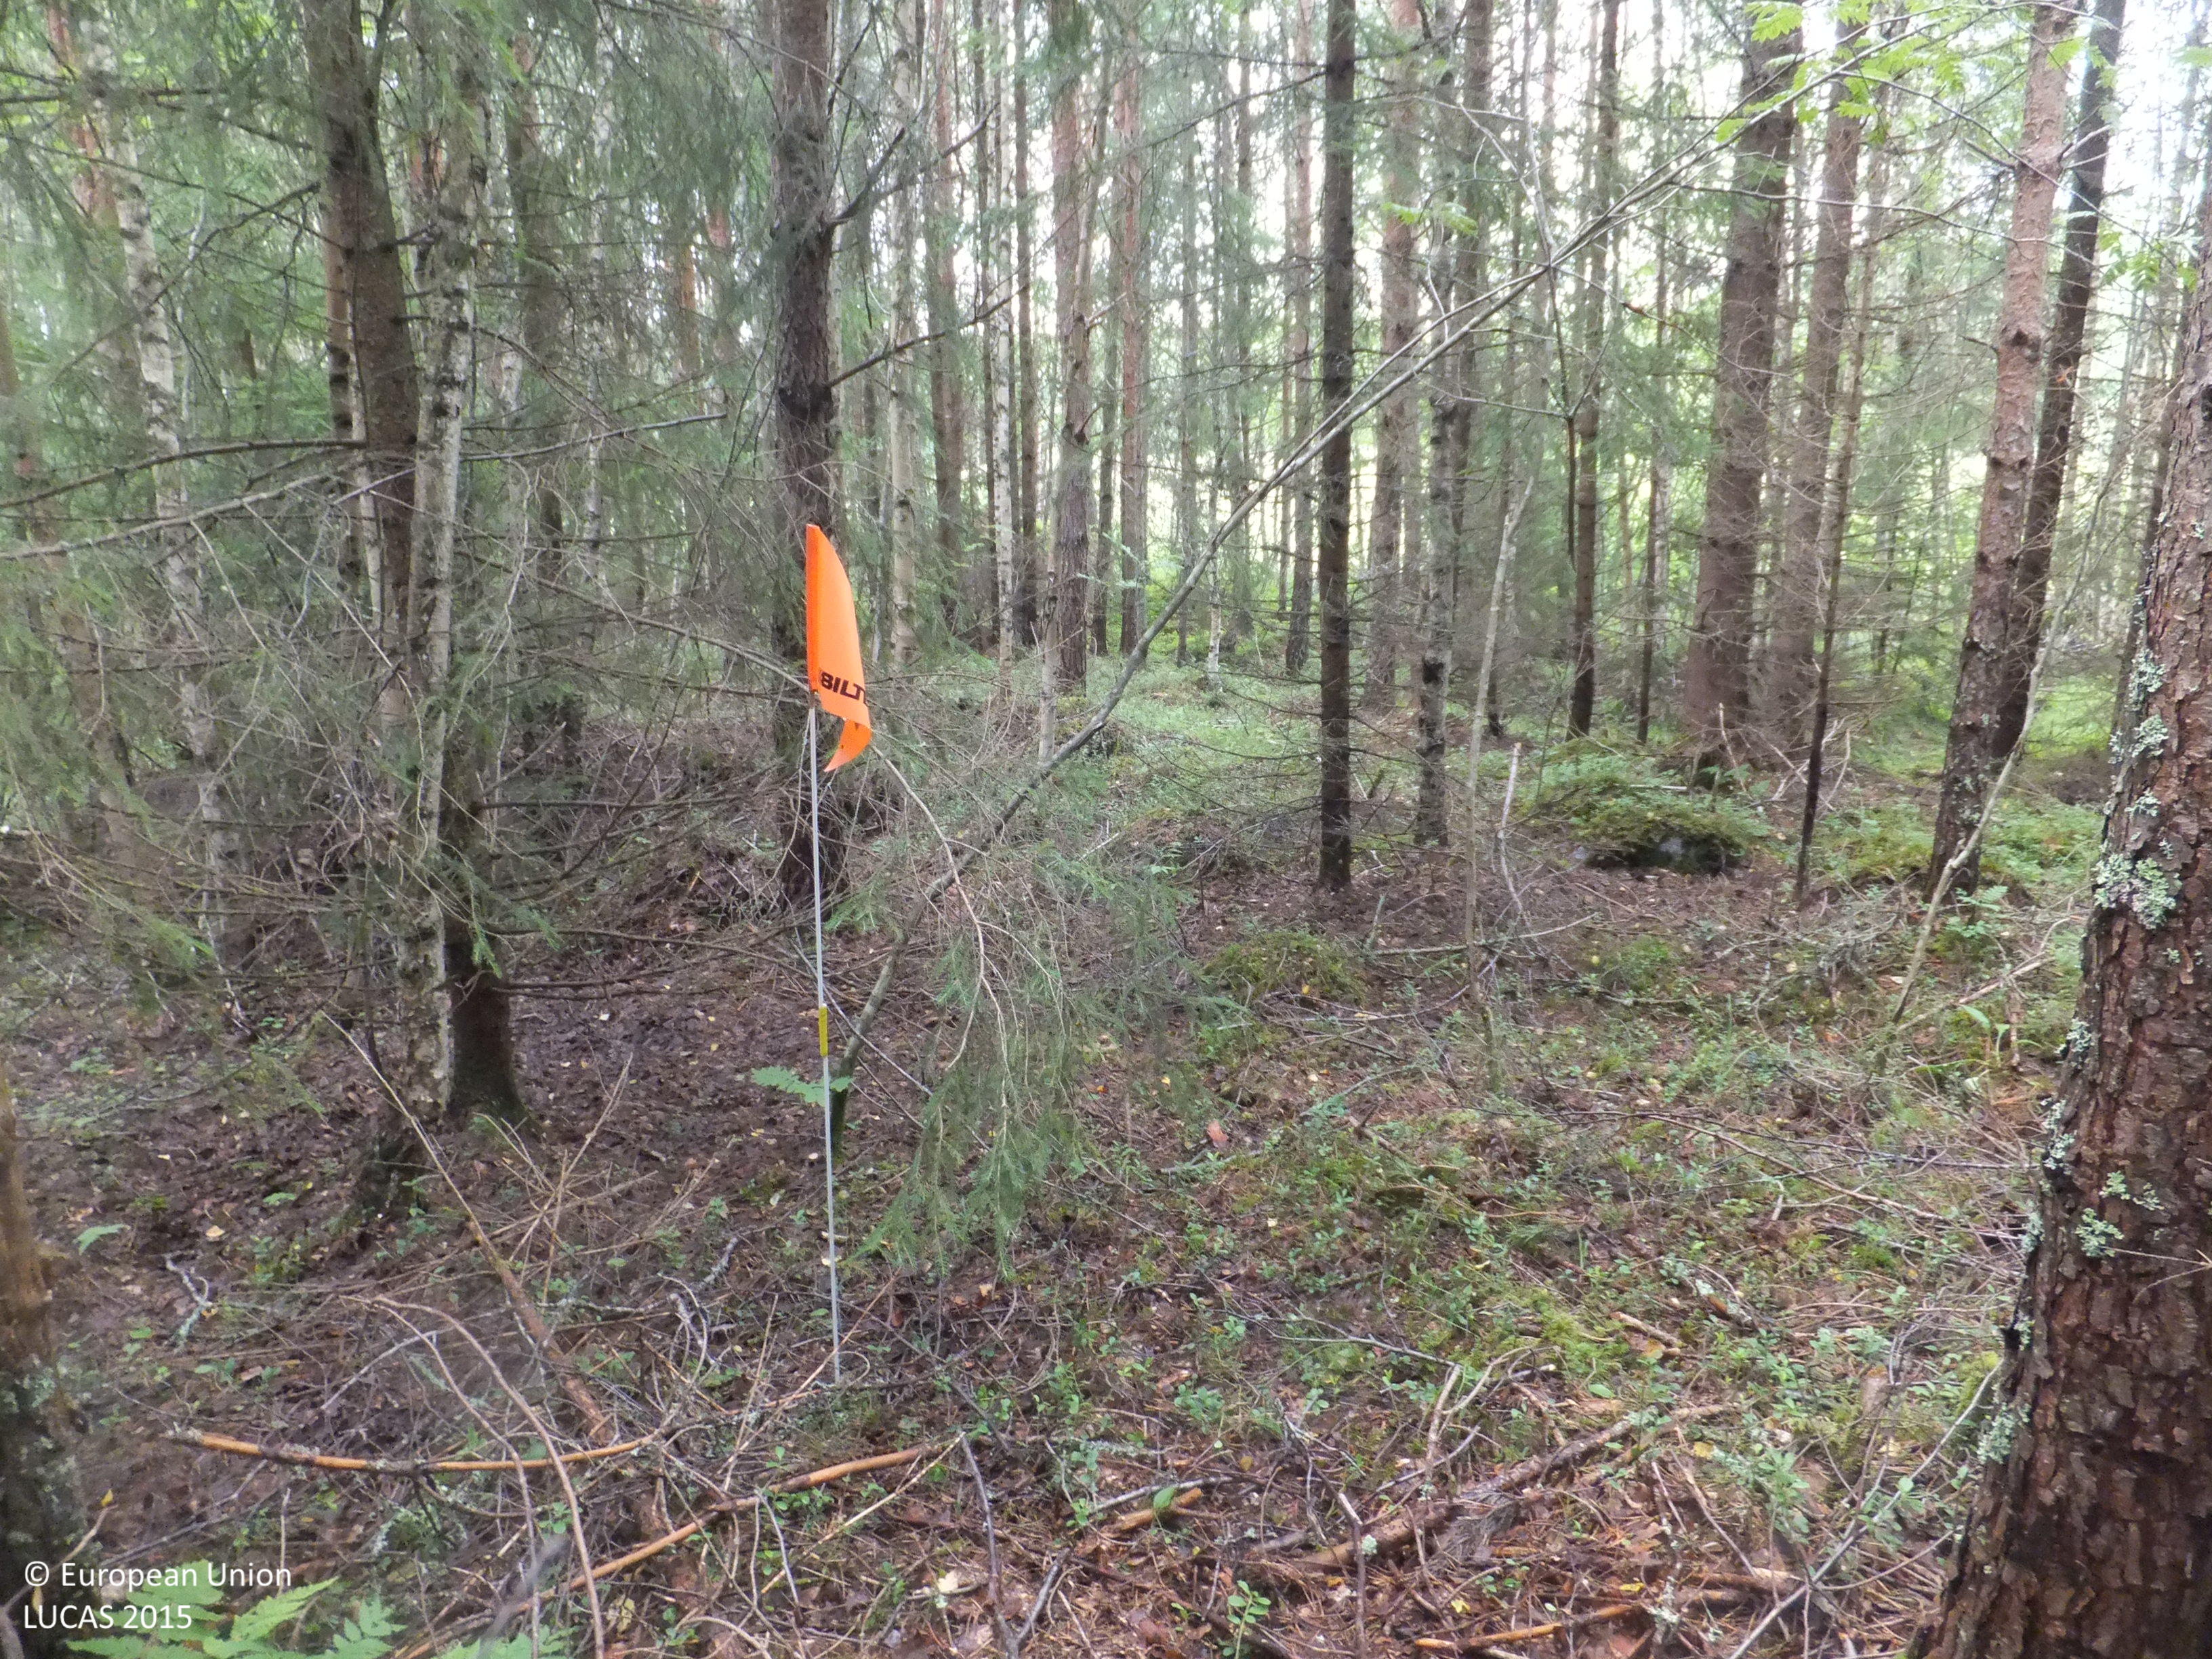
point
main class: Woodland
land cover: Other mixed woodland
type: boreal forest
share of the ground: > 75 %
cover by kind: broadleaved forest trees 45 %, coniferous forest trees 40 %, shrubs 5 %, herbaceous plants 5 %, lichens and mosses 5 %
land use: Forestry
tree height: > 5 m
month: July
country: FI
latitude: 63.0387
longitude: 21.6057
